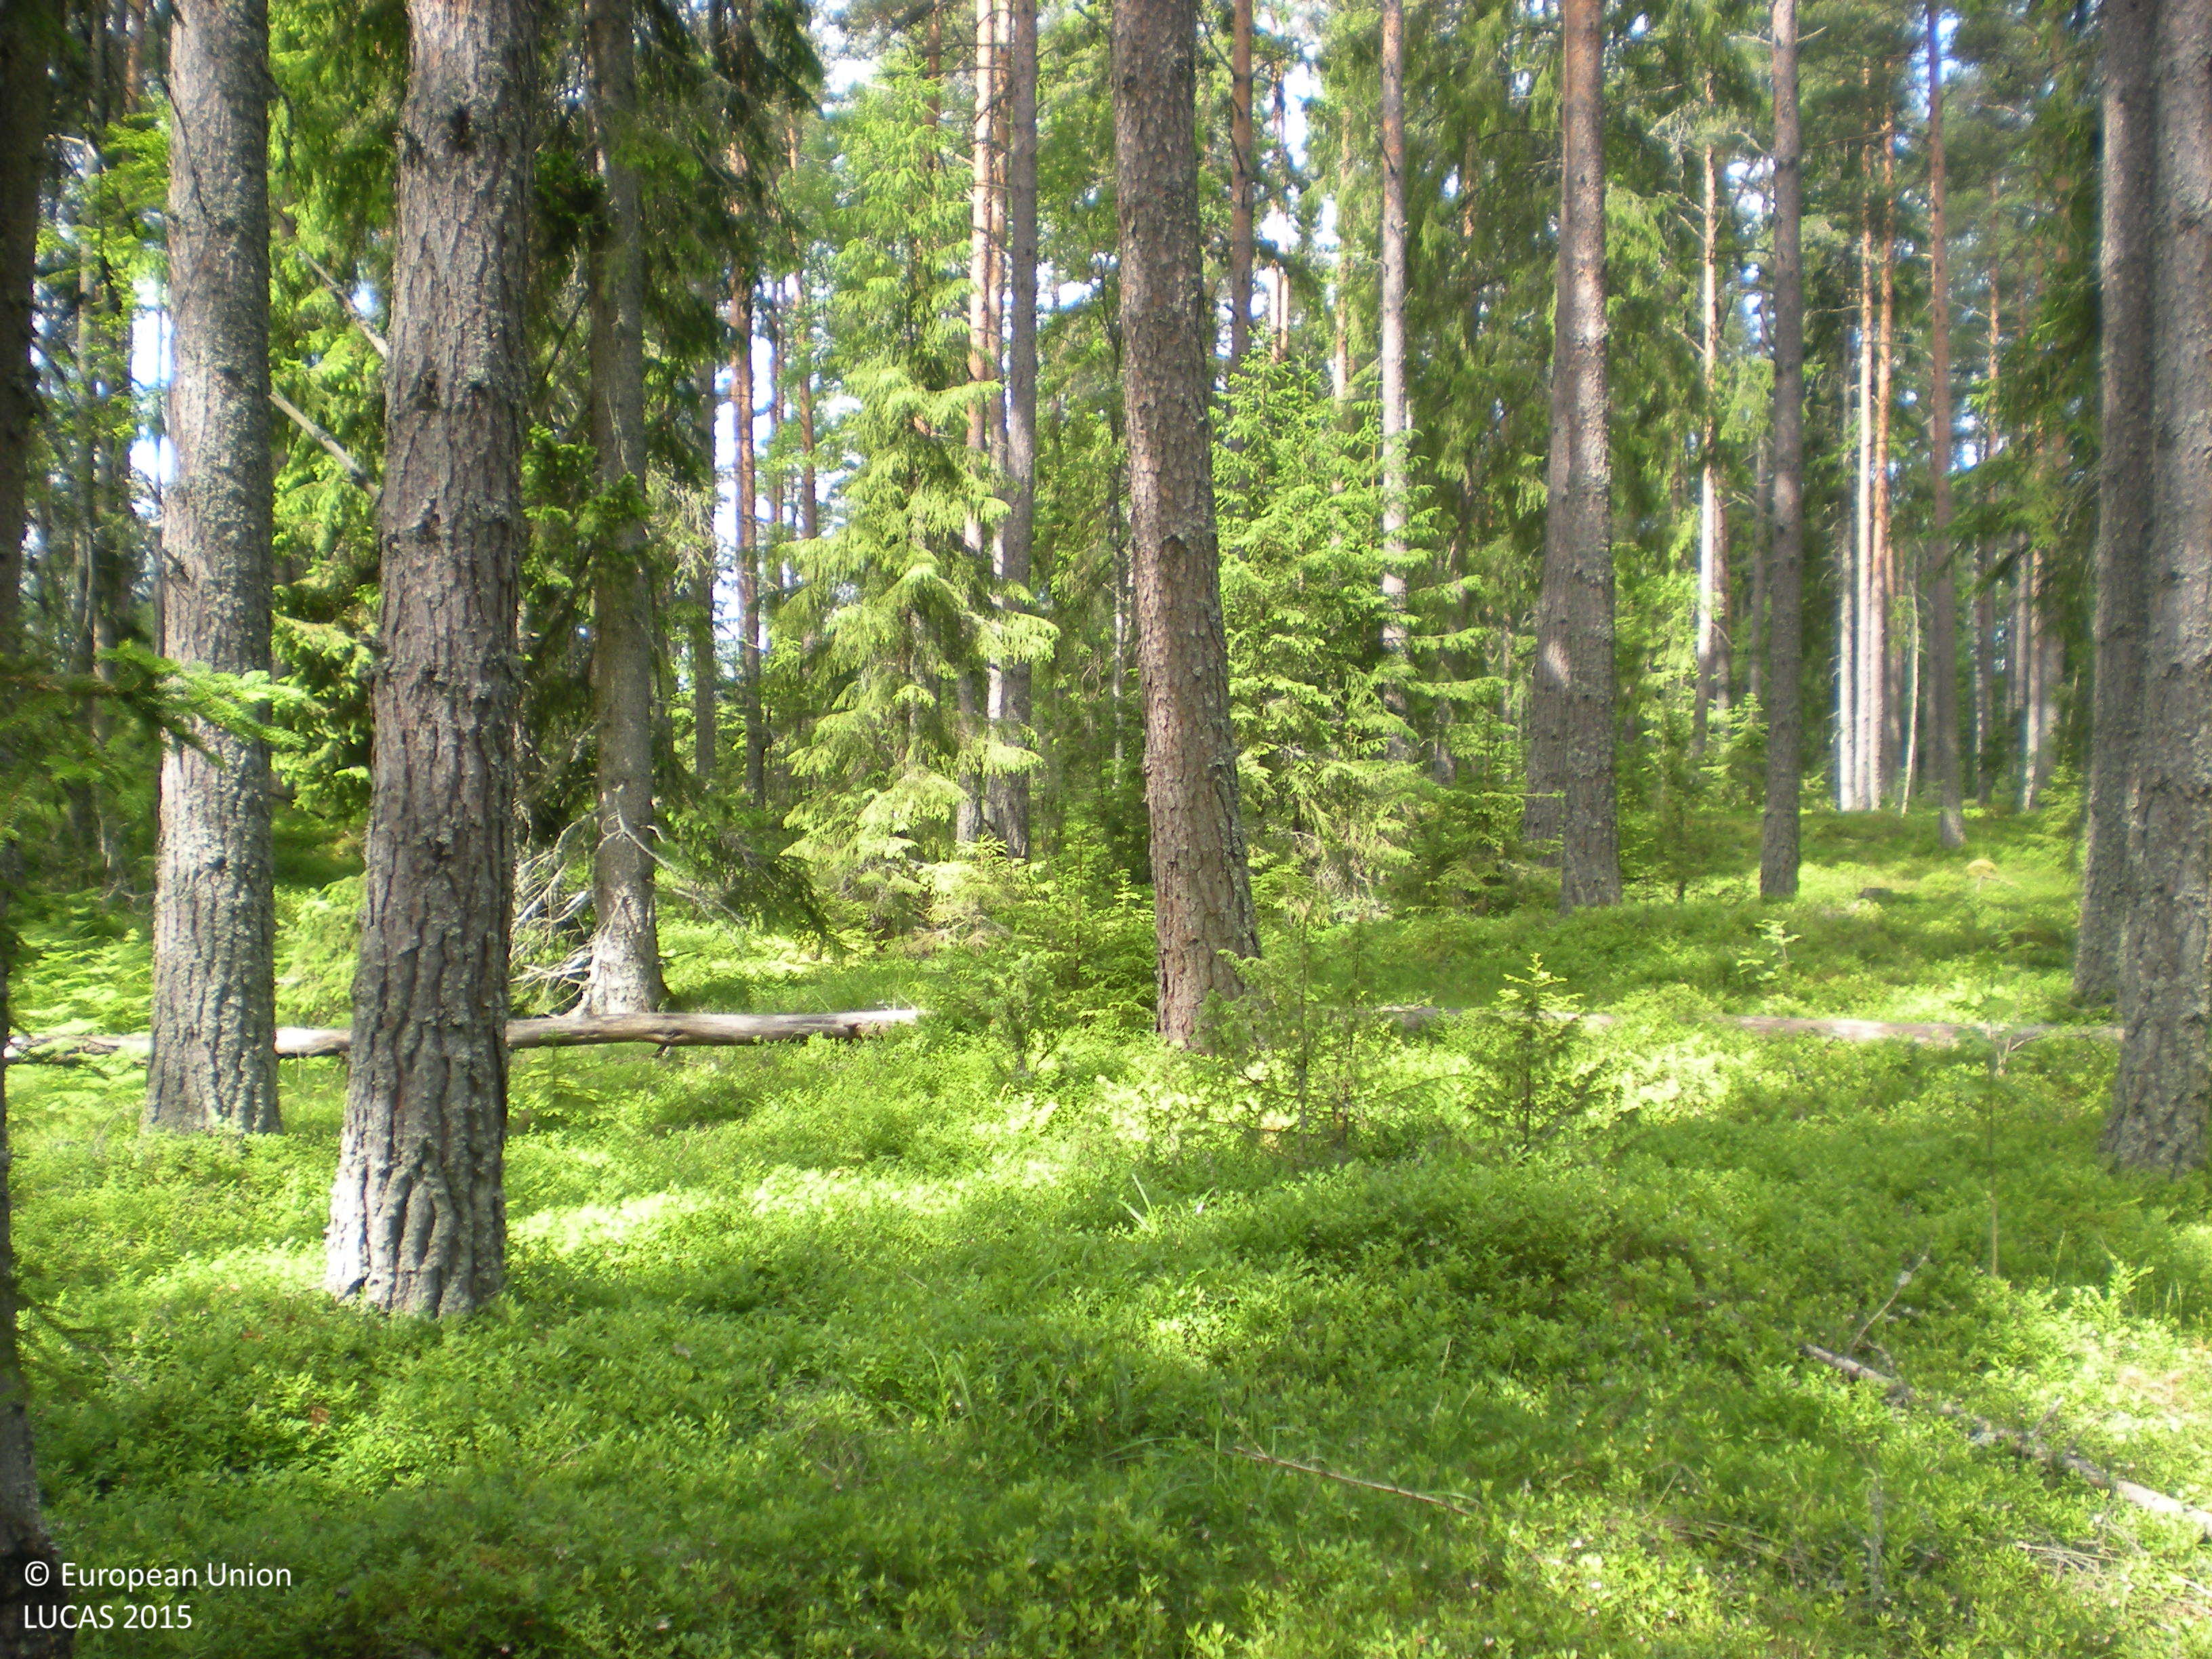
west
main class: Woodland
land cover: Pine dominated coniferous woodland
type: boreal forest
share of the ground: 50 - 75 %
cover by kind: coniferous forest trees 70 %, shrubs 20 %, herbaceous plants 5 %, lichens and mosses 5 %
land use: Forestry
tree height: > 5 m
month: June
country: SE
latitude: 60.4577
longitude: 18.0477
